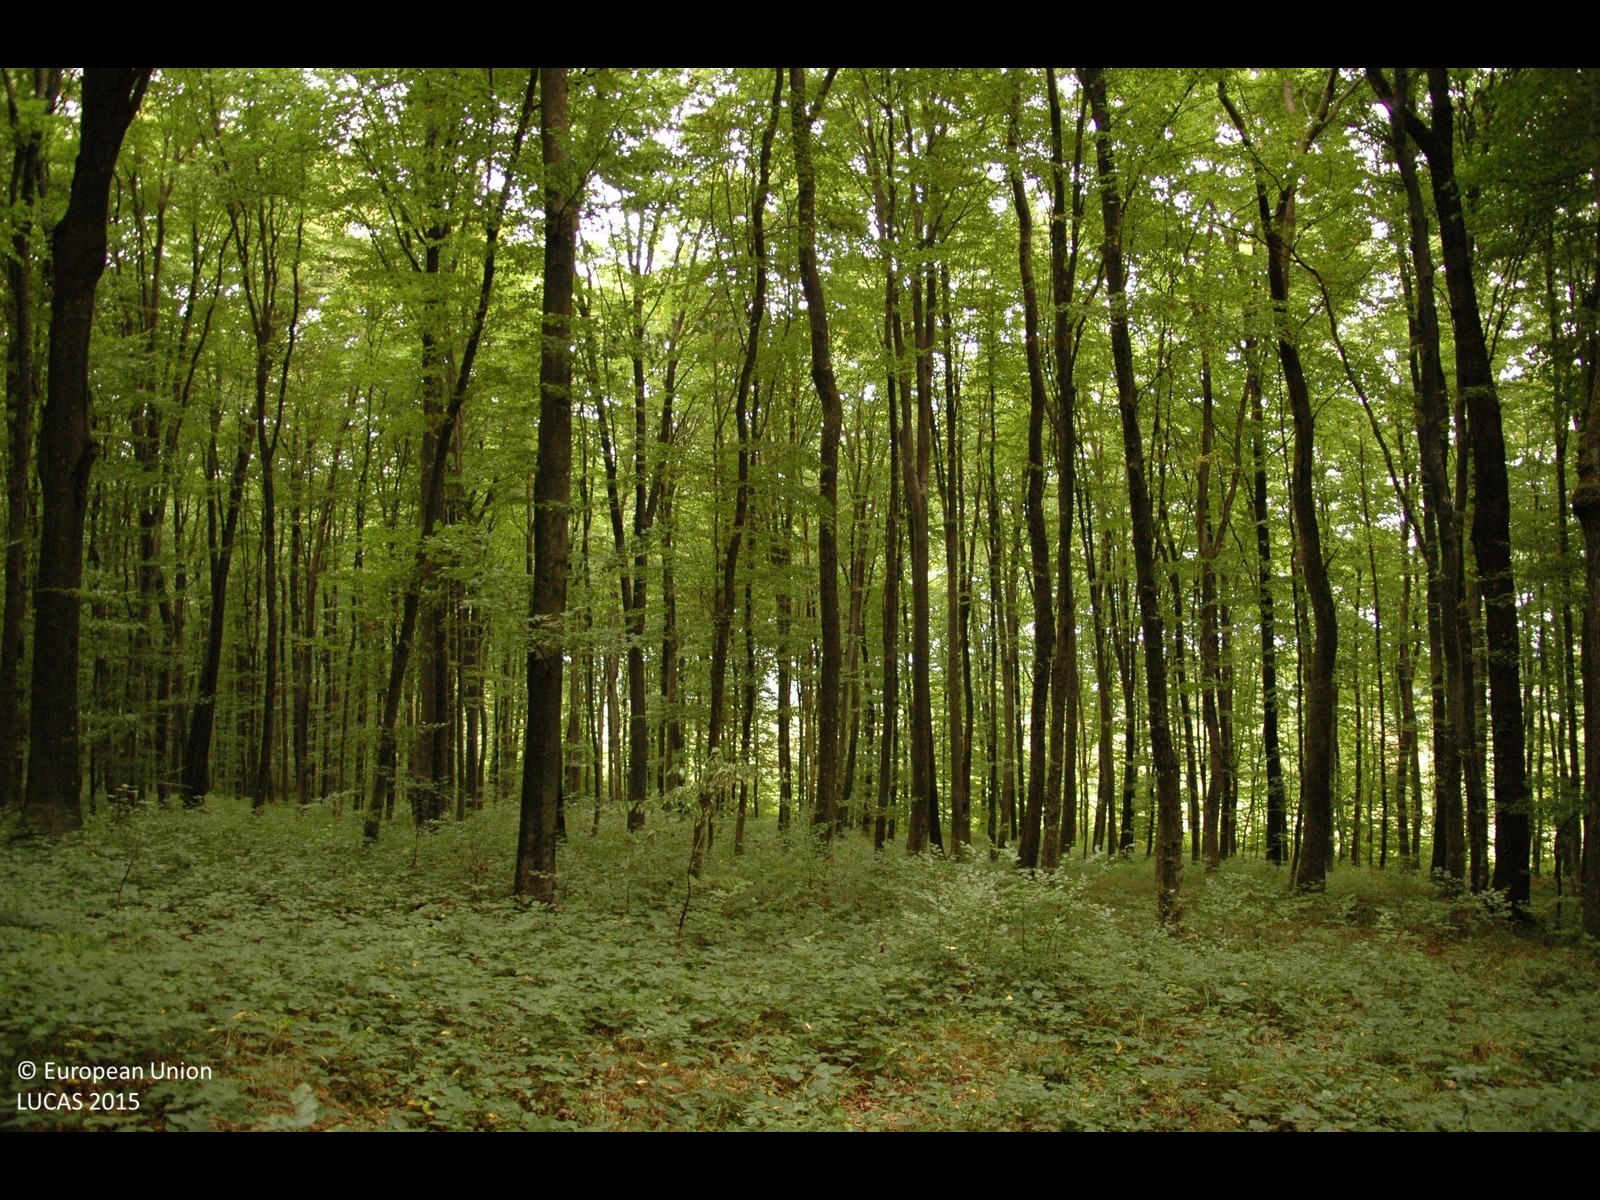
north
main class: Woodland
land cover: Broadleaved woodland
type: mesophytic deciduous forest
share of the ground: > 75 %
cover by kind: broadleaved forest trees 100 %
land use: Forestry
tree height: > 5 m
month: September
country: HR
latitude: 46.0681
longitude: 16.7103
